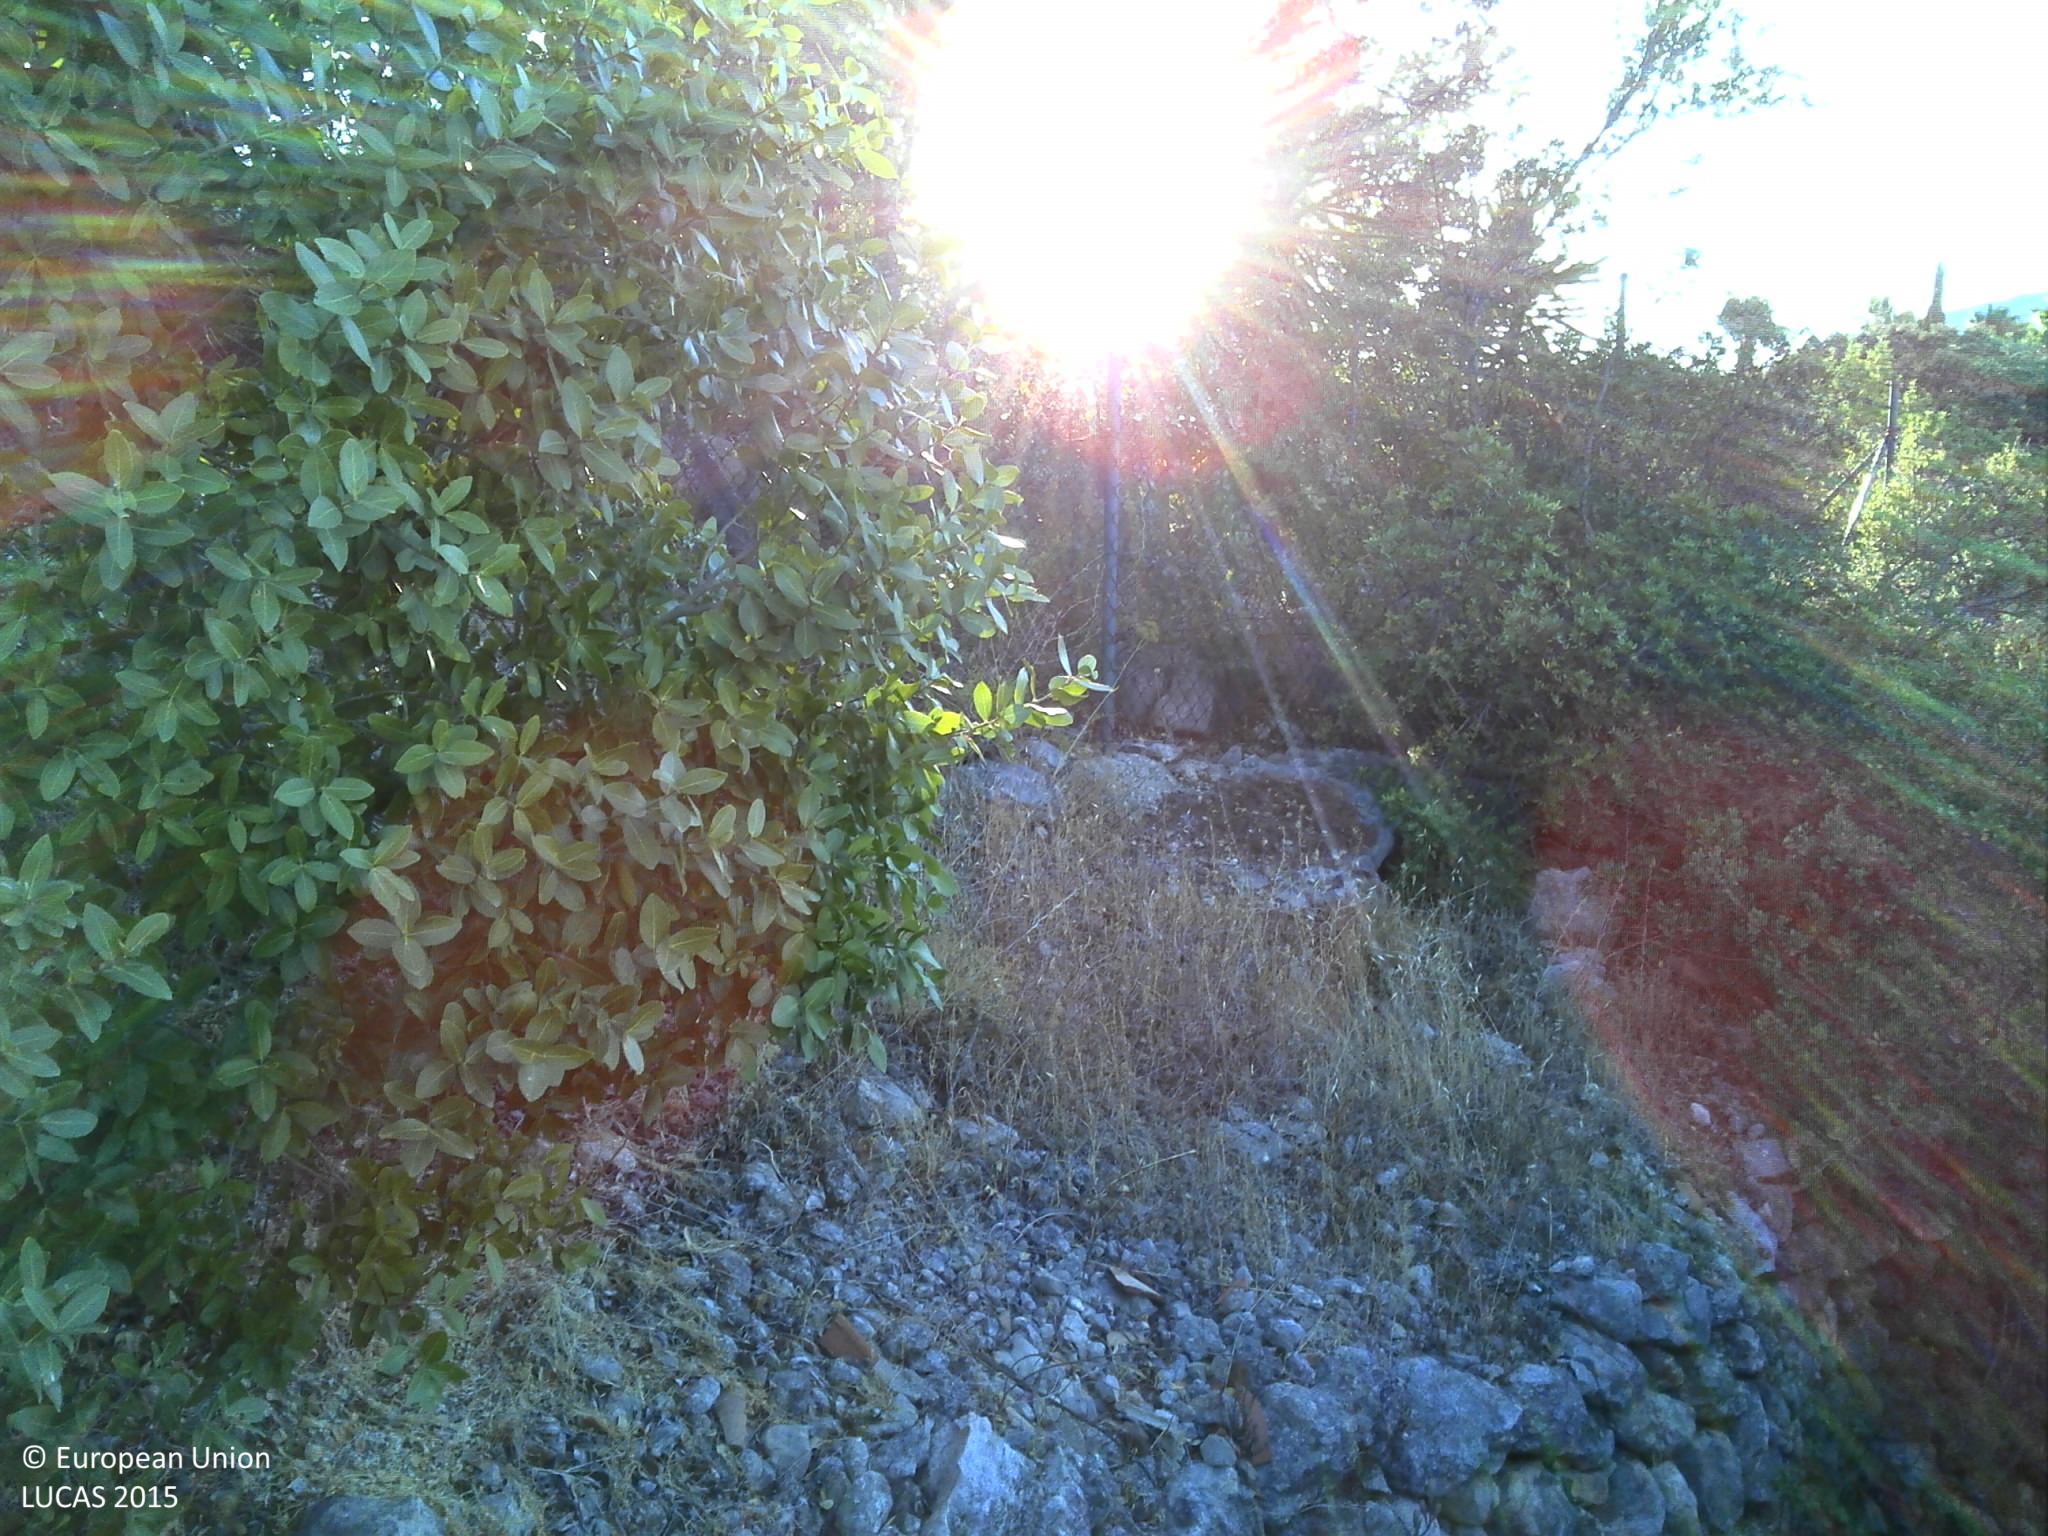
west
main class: Woodland
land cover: Broadleaved woodland
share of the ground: 25 - 50 %
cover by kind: broadleaved forest trees 40 %, unconsolidated bare surface 40 %, herbaceous plants 20 %
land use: Residential
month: June
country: PT
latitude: 37.0870
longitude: -7.8160
